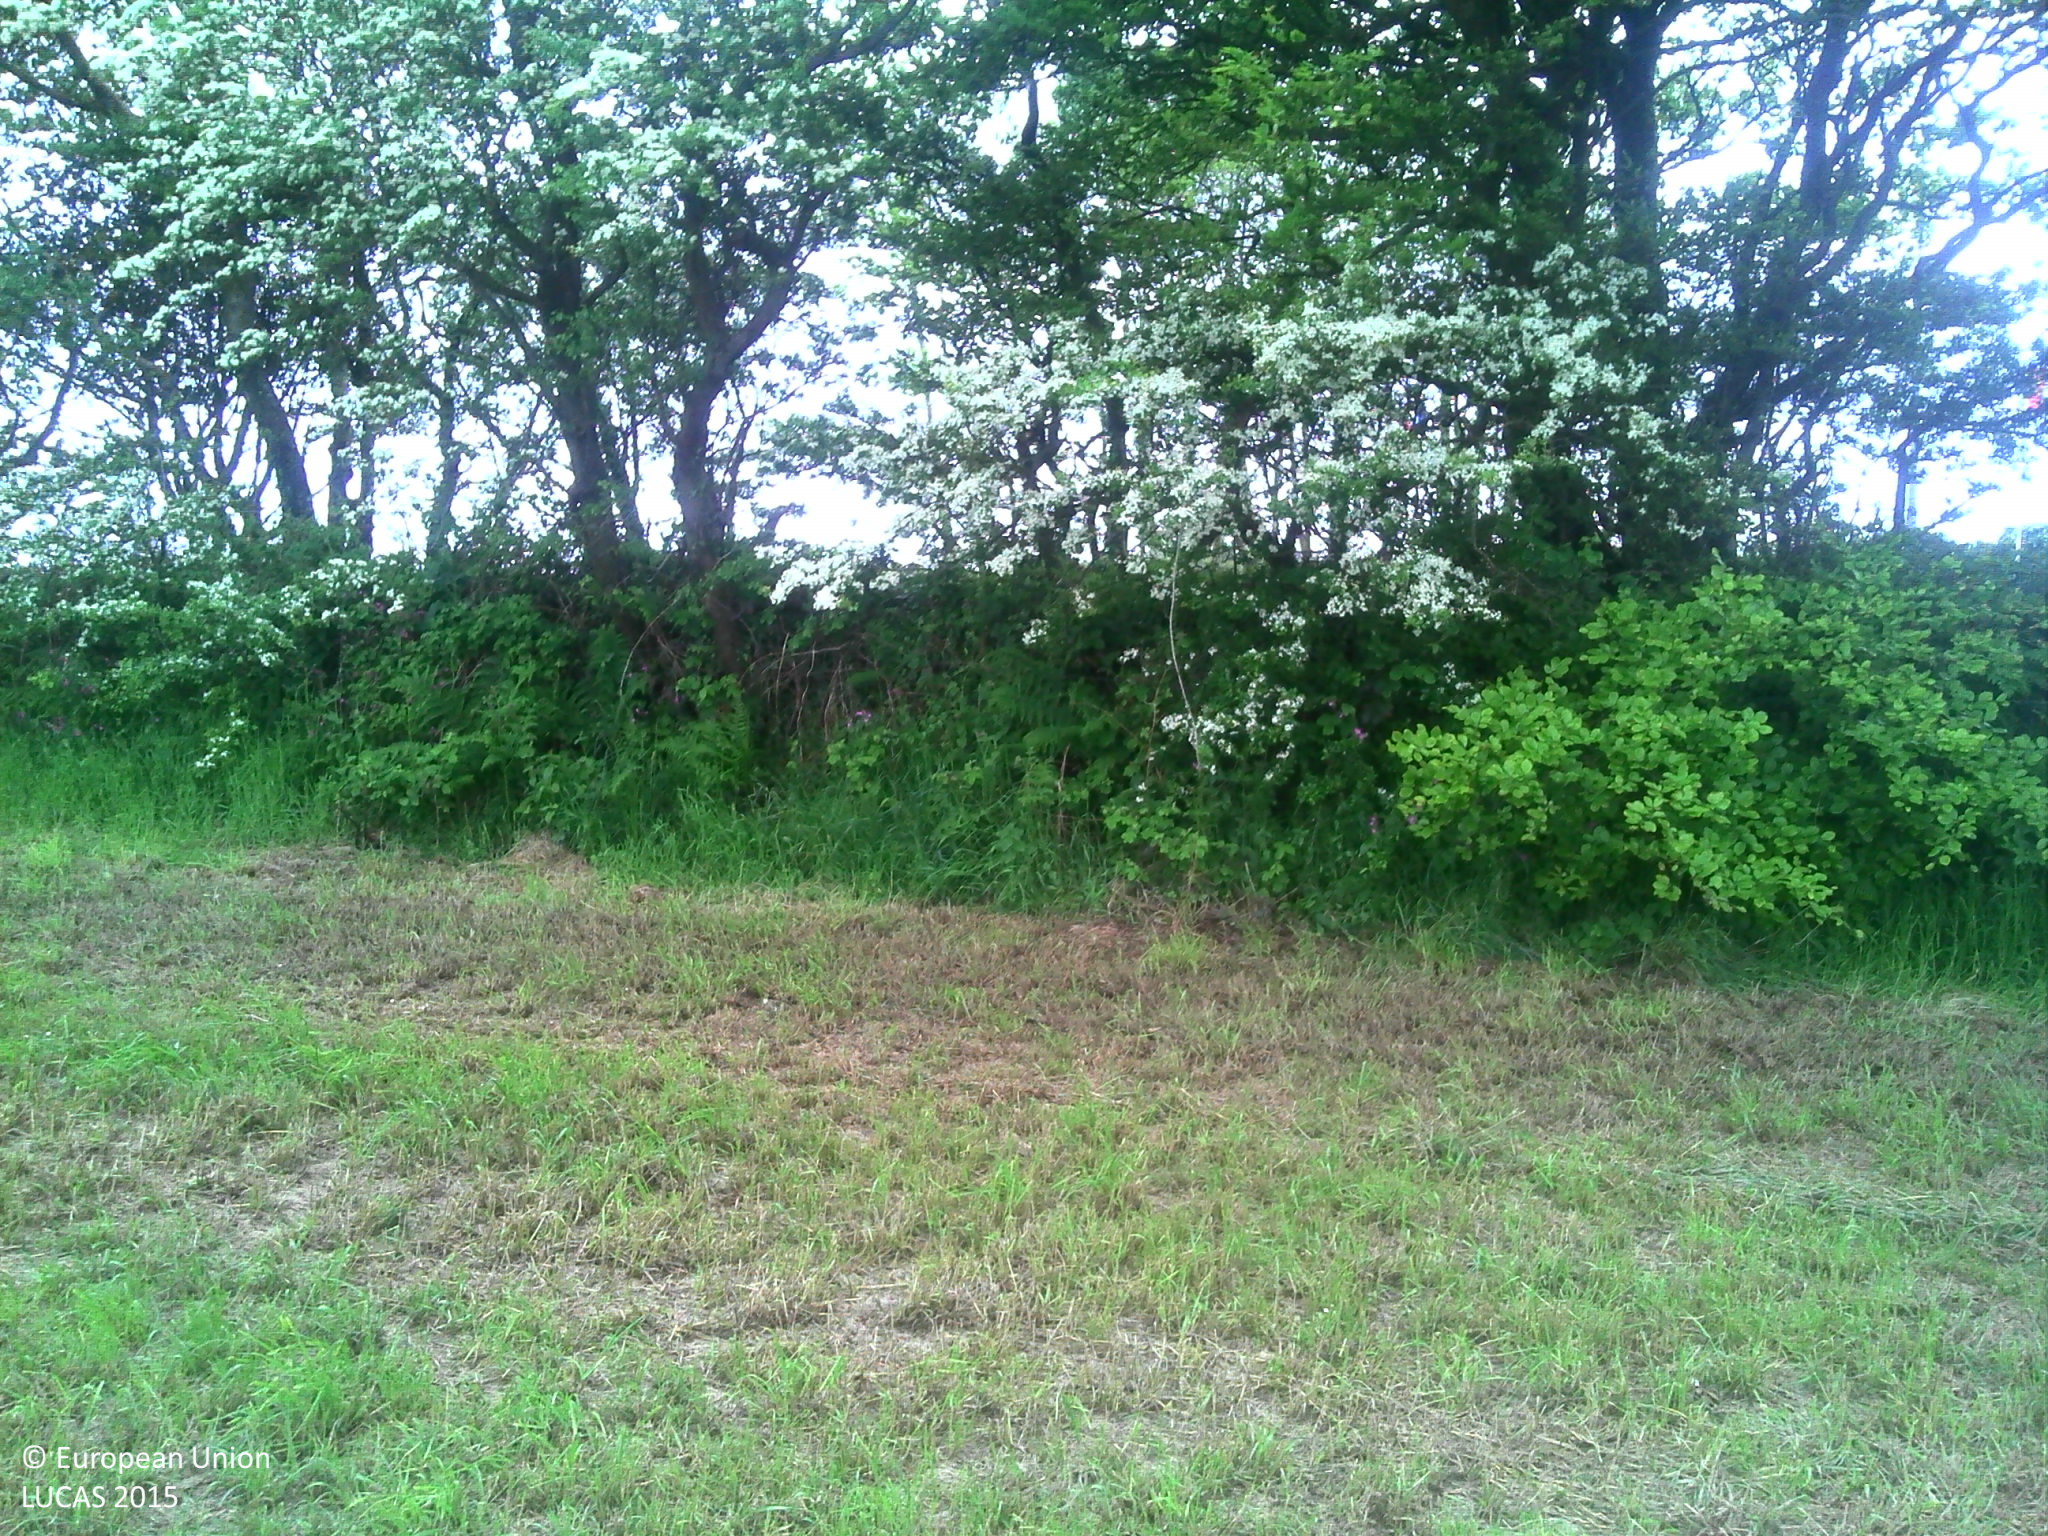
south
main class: Grassland
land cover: Grassland without tree/shrub cover
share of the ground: > 75 %
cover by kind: herbaceous plants 100 %
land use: Agriculture (excluding fallow land and kitchen gardens)
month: June
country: FR
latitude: 49.6583
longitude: -1.8152
